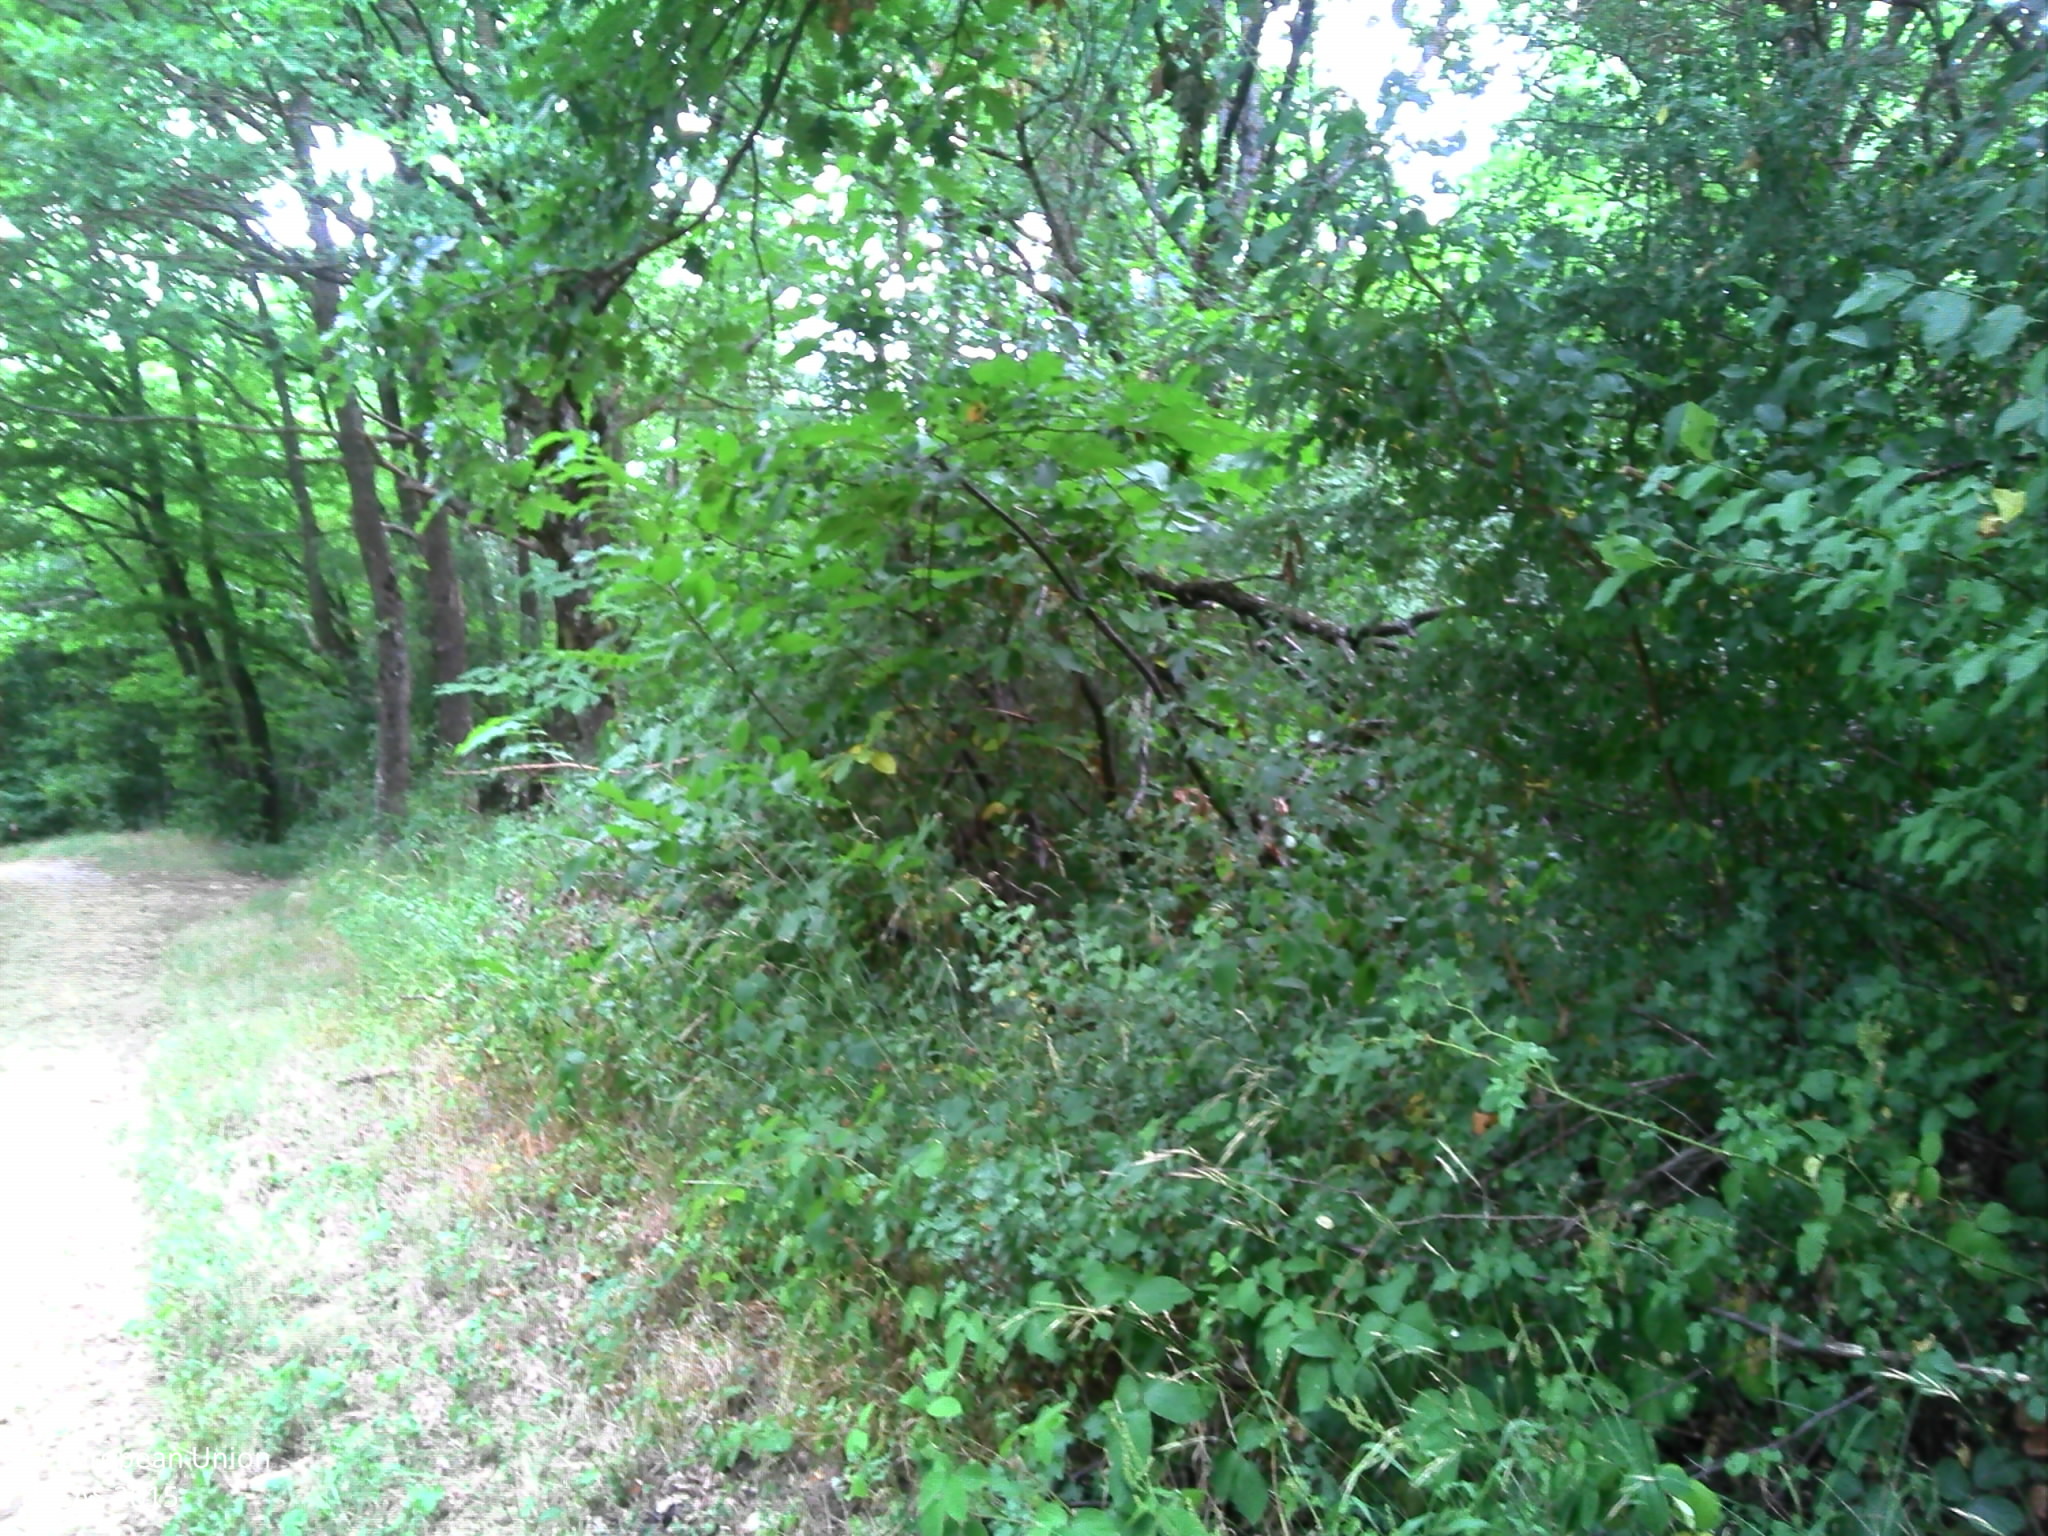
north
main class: Woodland
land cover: Broadleaved woodland
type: thermophilous deciduous forest
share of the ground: > 75 %
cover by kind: broadleaved forest trees 85 %, herbaceous plants 15 %
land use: Agriculture (excluding fallow land and kitchen gardens)
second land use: Forestry
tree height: > 5 m
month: July
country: FR
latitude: 45.4224
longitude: 5.0075
